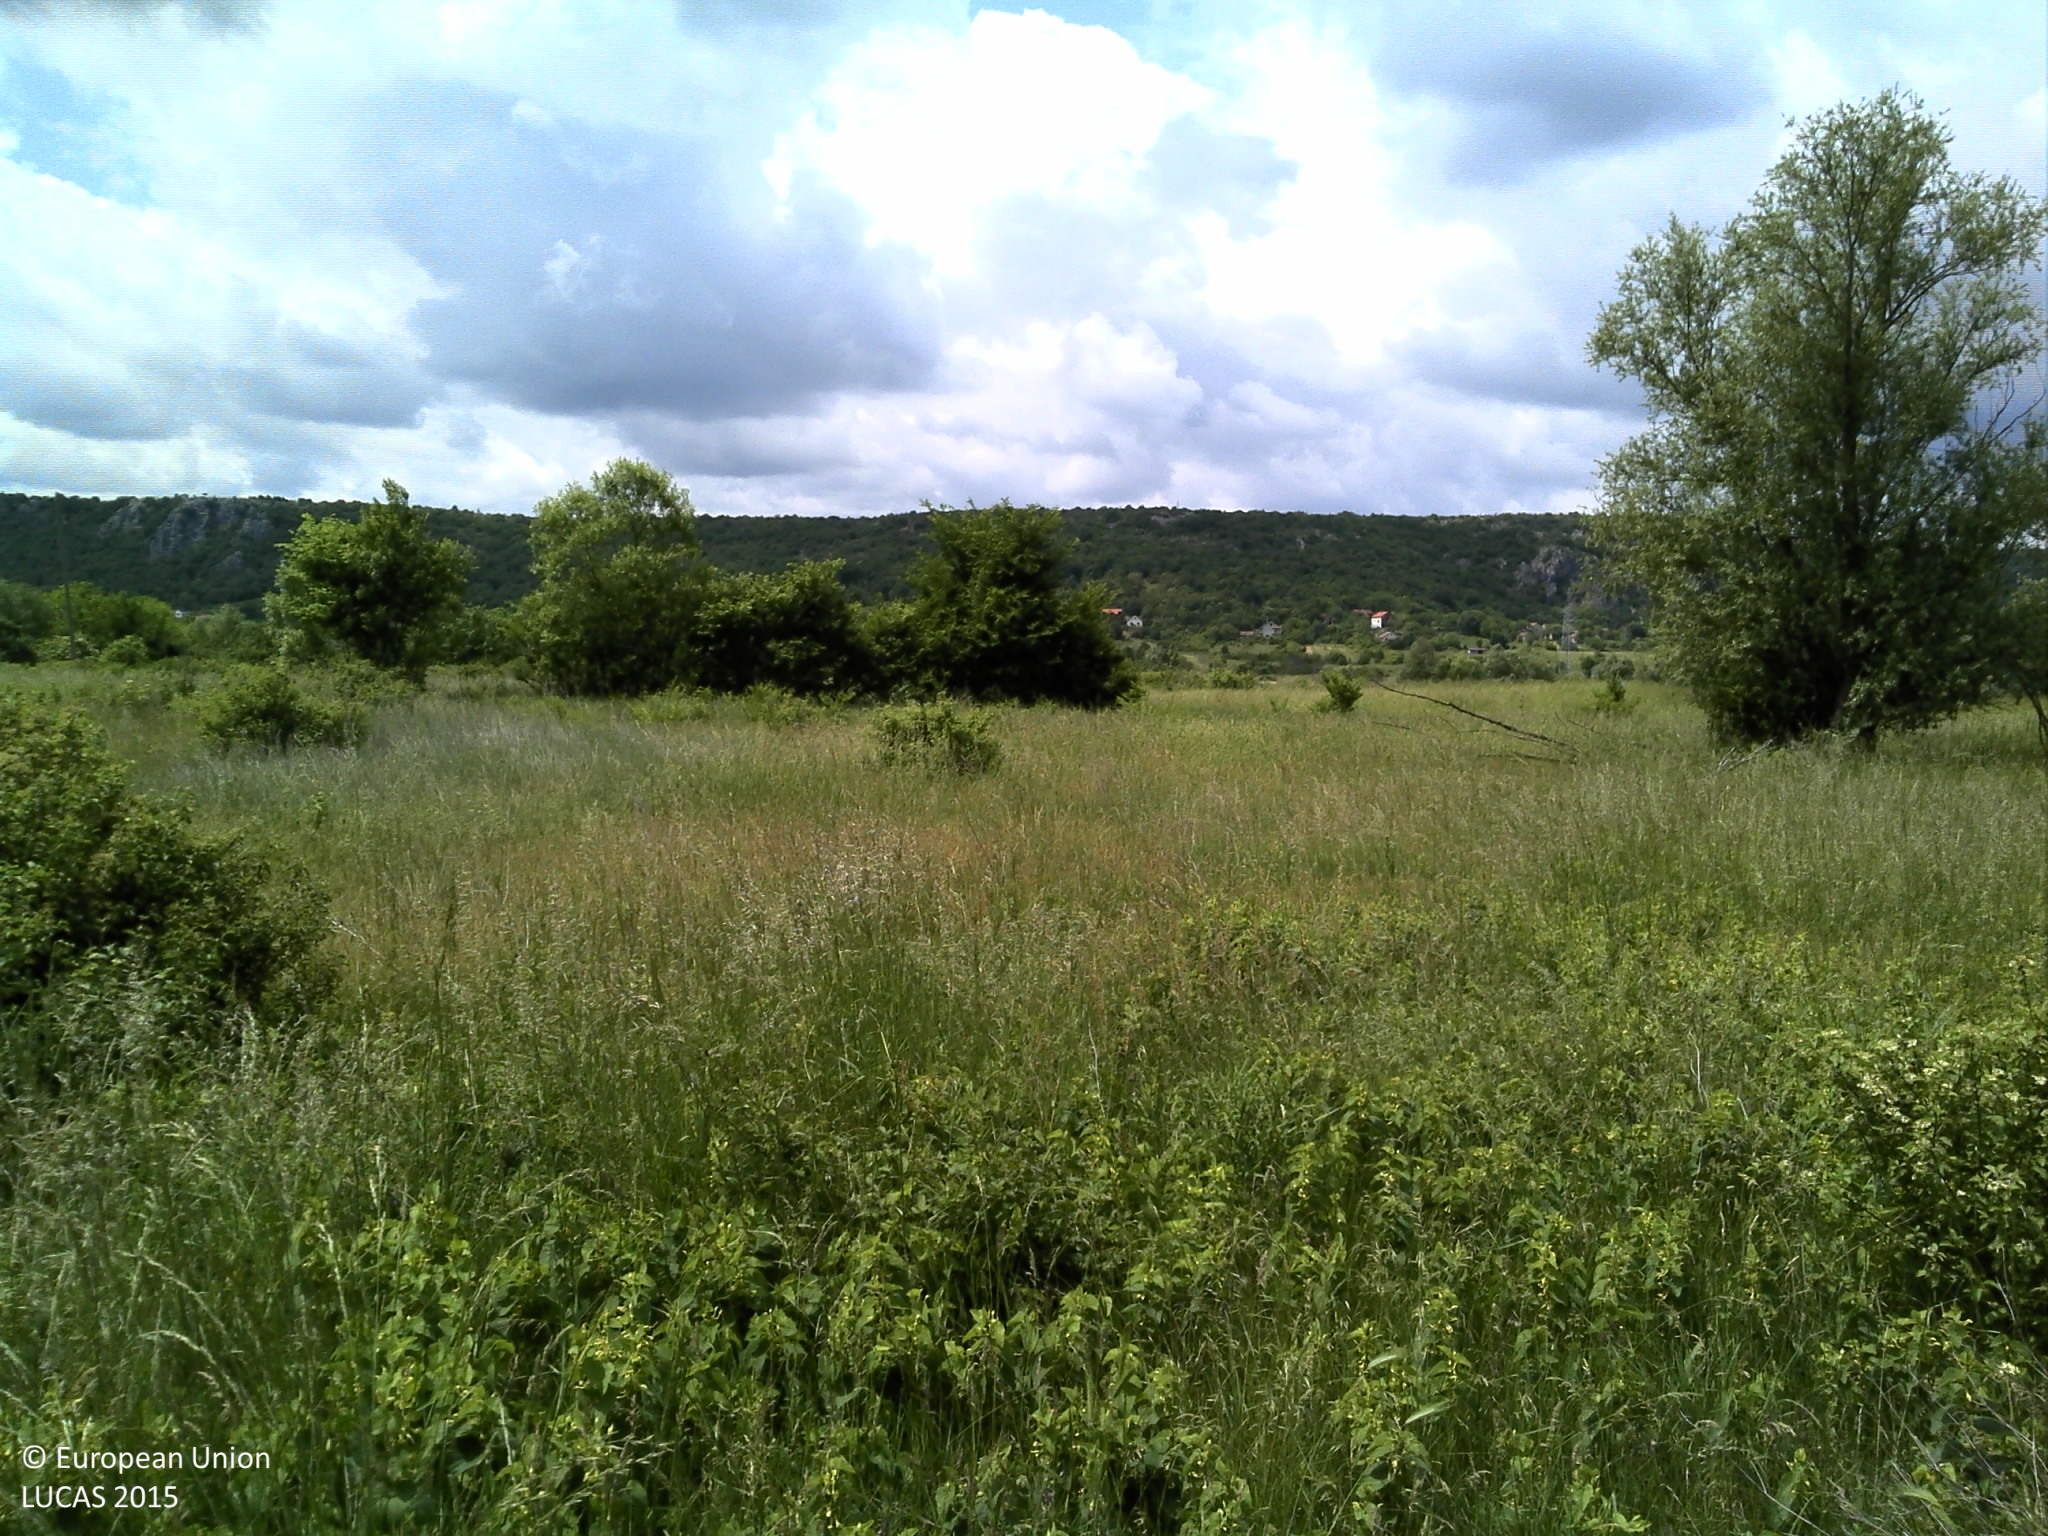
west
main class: Grassland
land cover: Grassland without tree/shrub cover
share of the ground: > 75 %
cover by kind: herbaceous plants 100 %
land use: Abandoned areas
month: May
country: HR
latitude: 44.0014
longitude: 16.2155
